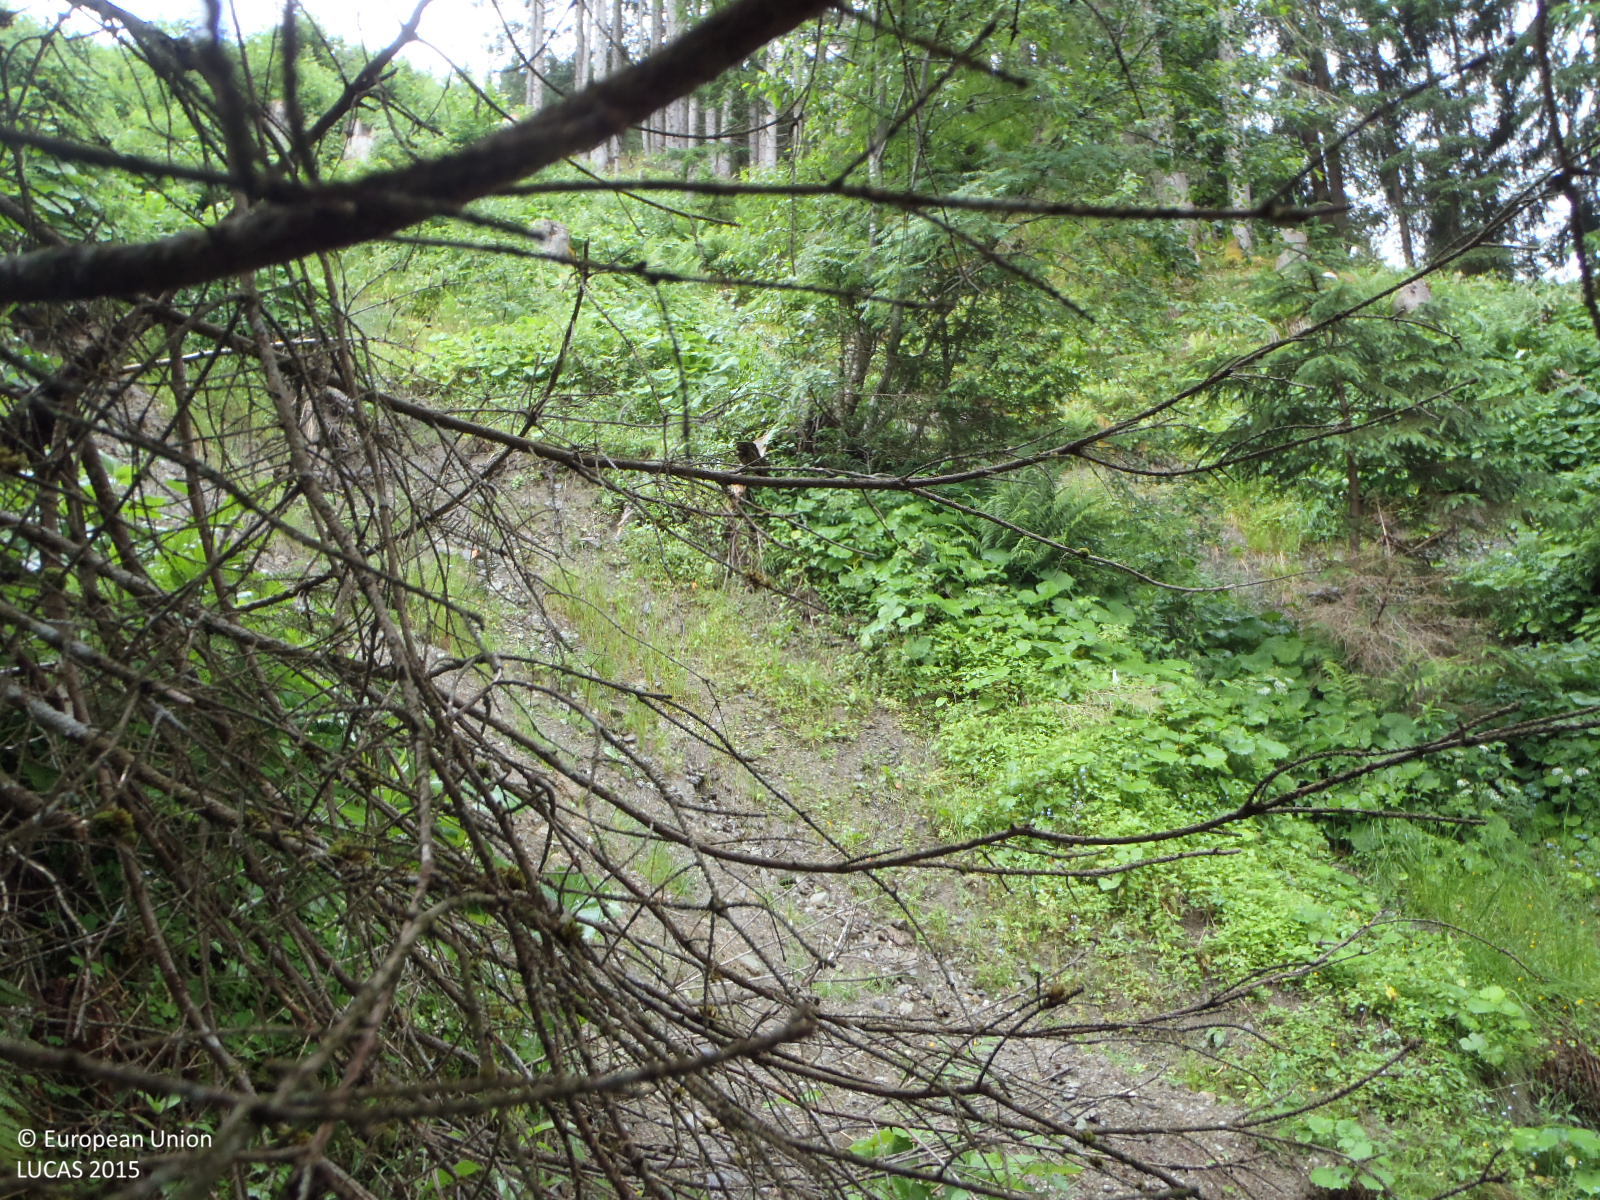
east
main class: Woodland
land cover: Spruce dominated coniferous woodland
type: alpine coniferous forest
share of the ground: > 75 %
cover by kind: coniferous forest trees 65 %, broadleaved forest trees 20 %, herbaceous plants 15 %
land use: Forestry
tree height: > 5 m
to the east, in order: Spruce dominated coniferous woodland; Rocks and stones; Shrubland with sparse tree cover; Spruce dominated coniferous woodland; Fences; Spruce dominated coniferous woodland; Grassland without tree/shrub cover; Rivers and streams; Spruce dominated coniferous woodland; Grassland with sparse tree/shrub cover; Spruce dominated coniferous woodland; Grassland without tree/shrub cover; Tracks; Grassland without tree/shrub cover
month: June
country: AT
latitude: 47.3791
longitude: 12.7399
